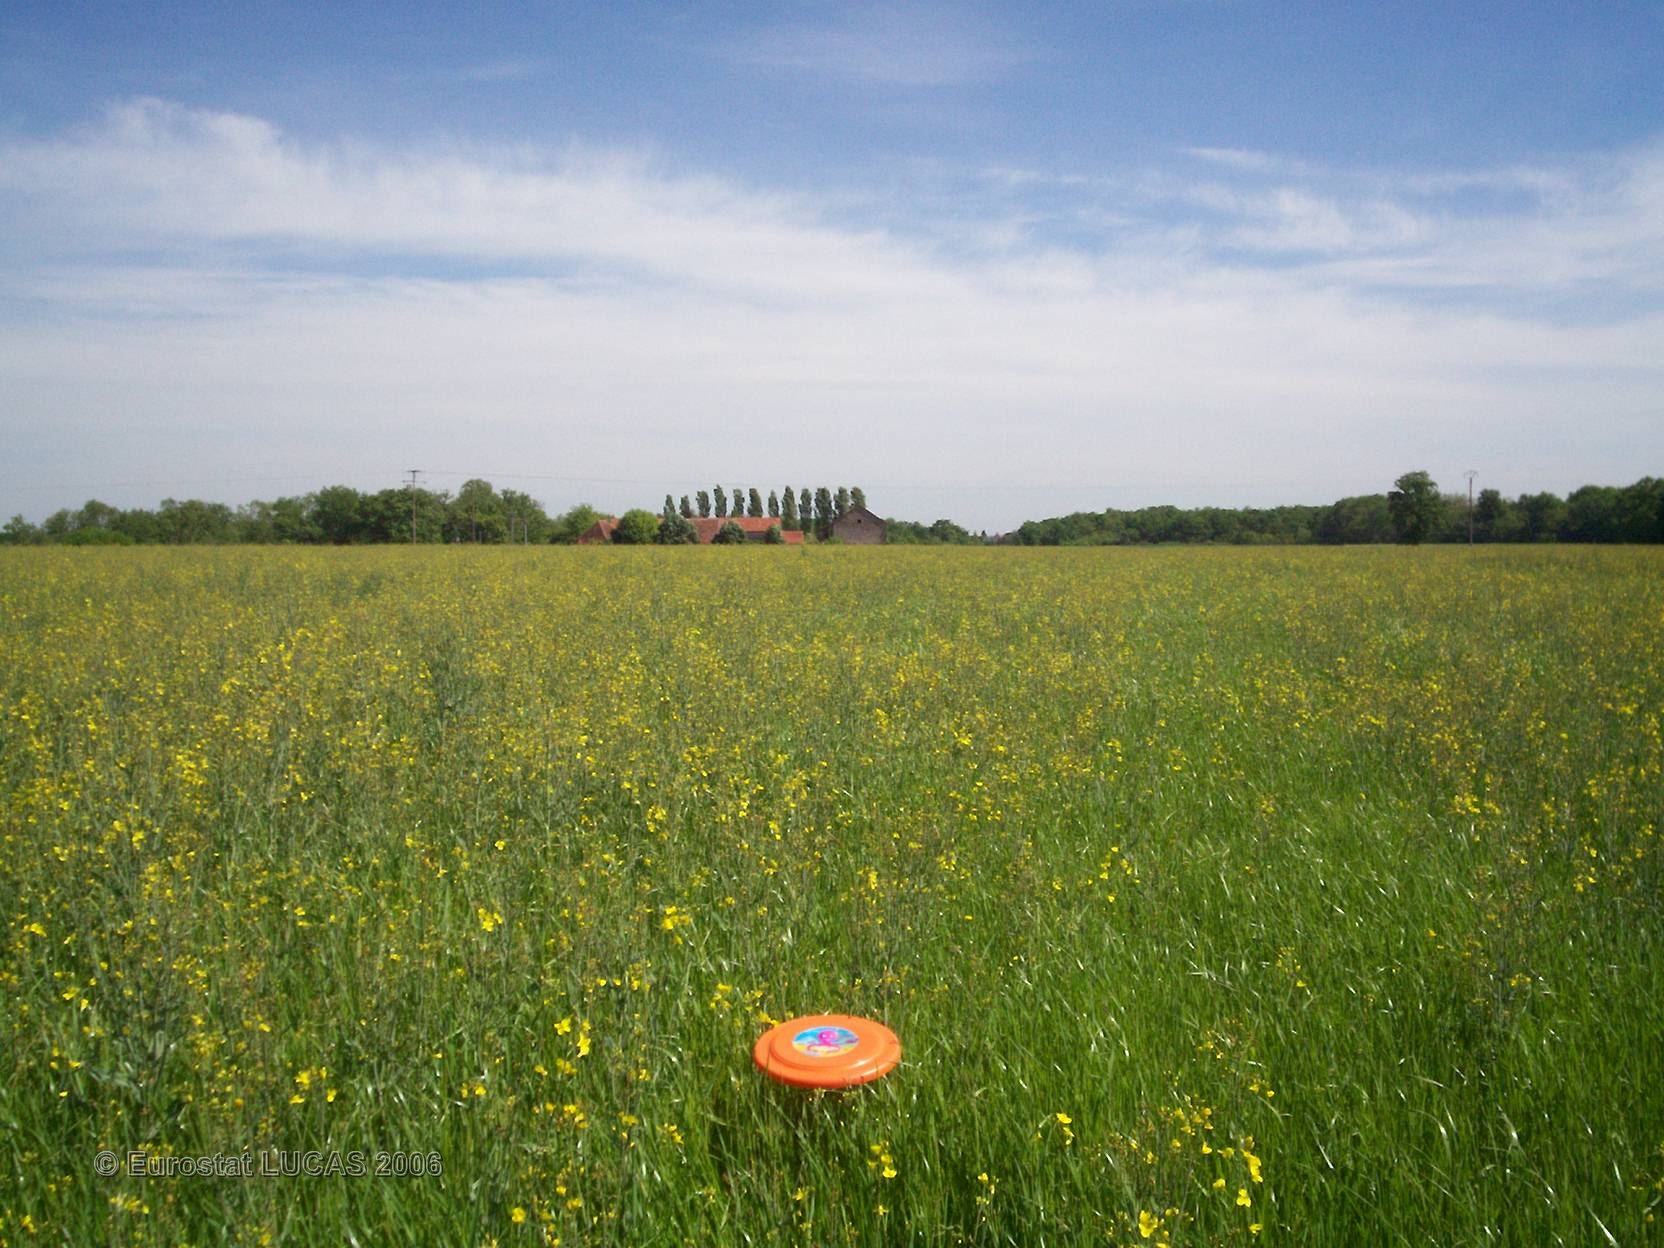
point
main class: Grassland
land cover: Grassland without tree/shrub cover
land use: Agriculture (excluding fallow land and kitchen gardens)
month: May
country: FR
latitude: 46.5996
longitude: 4.7146
